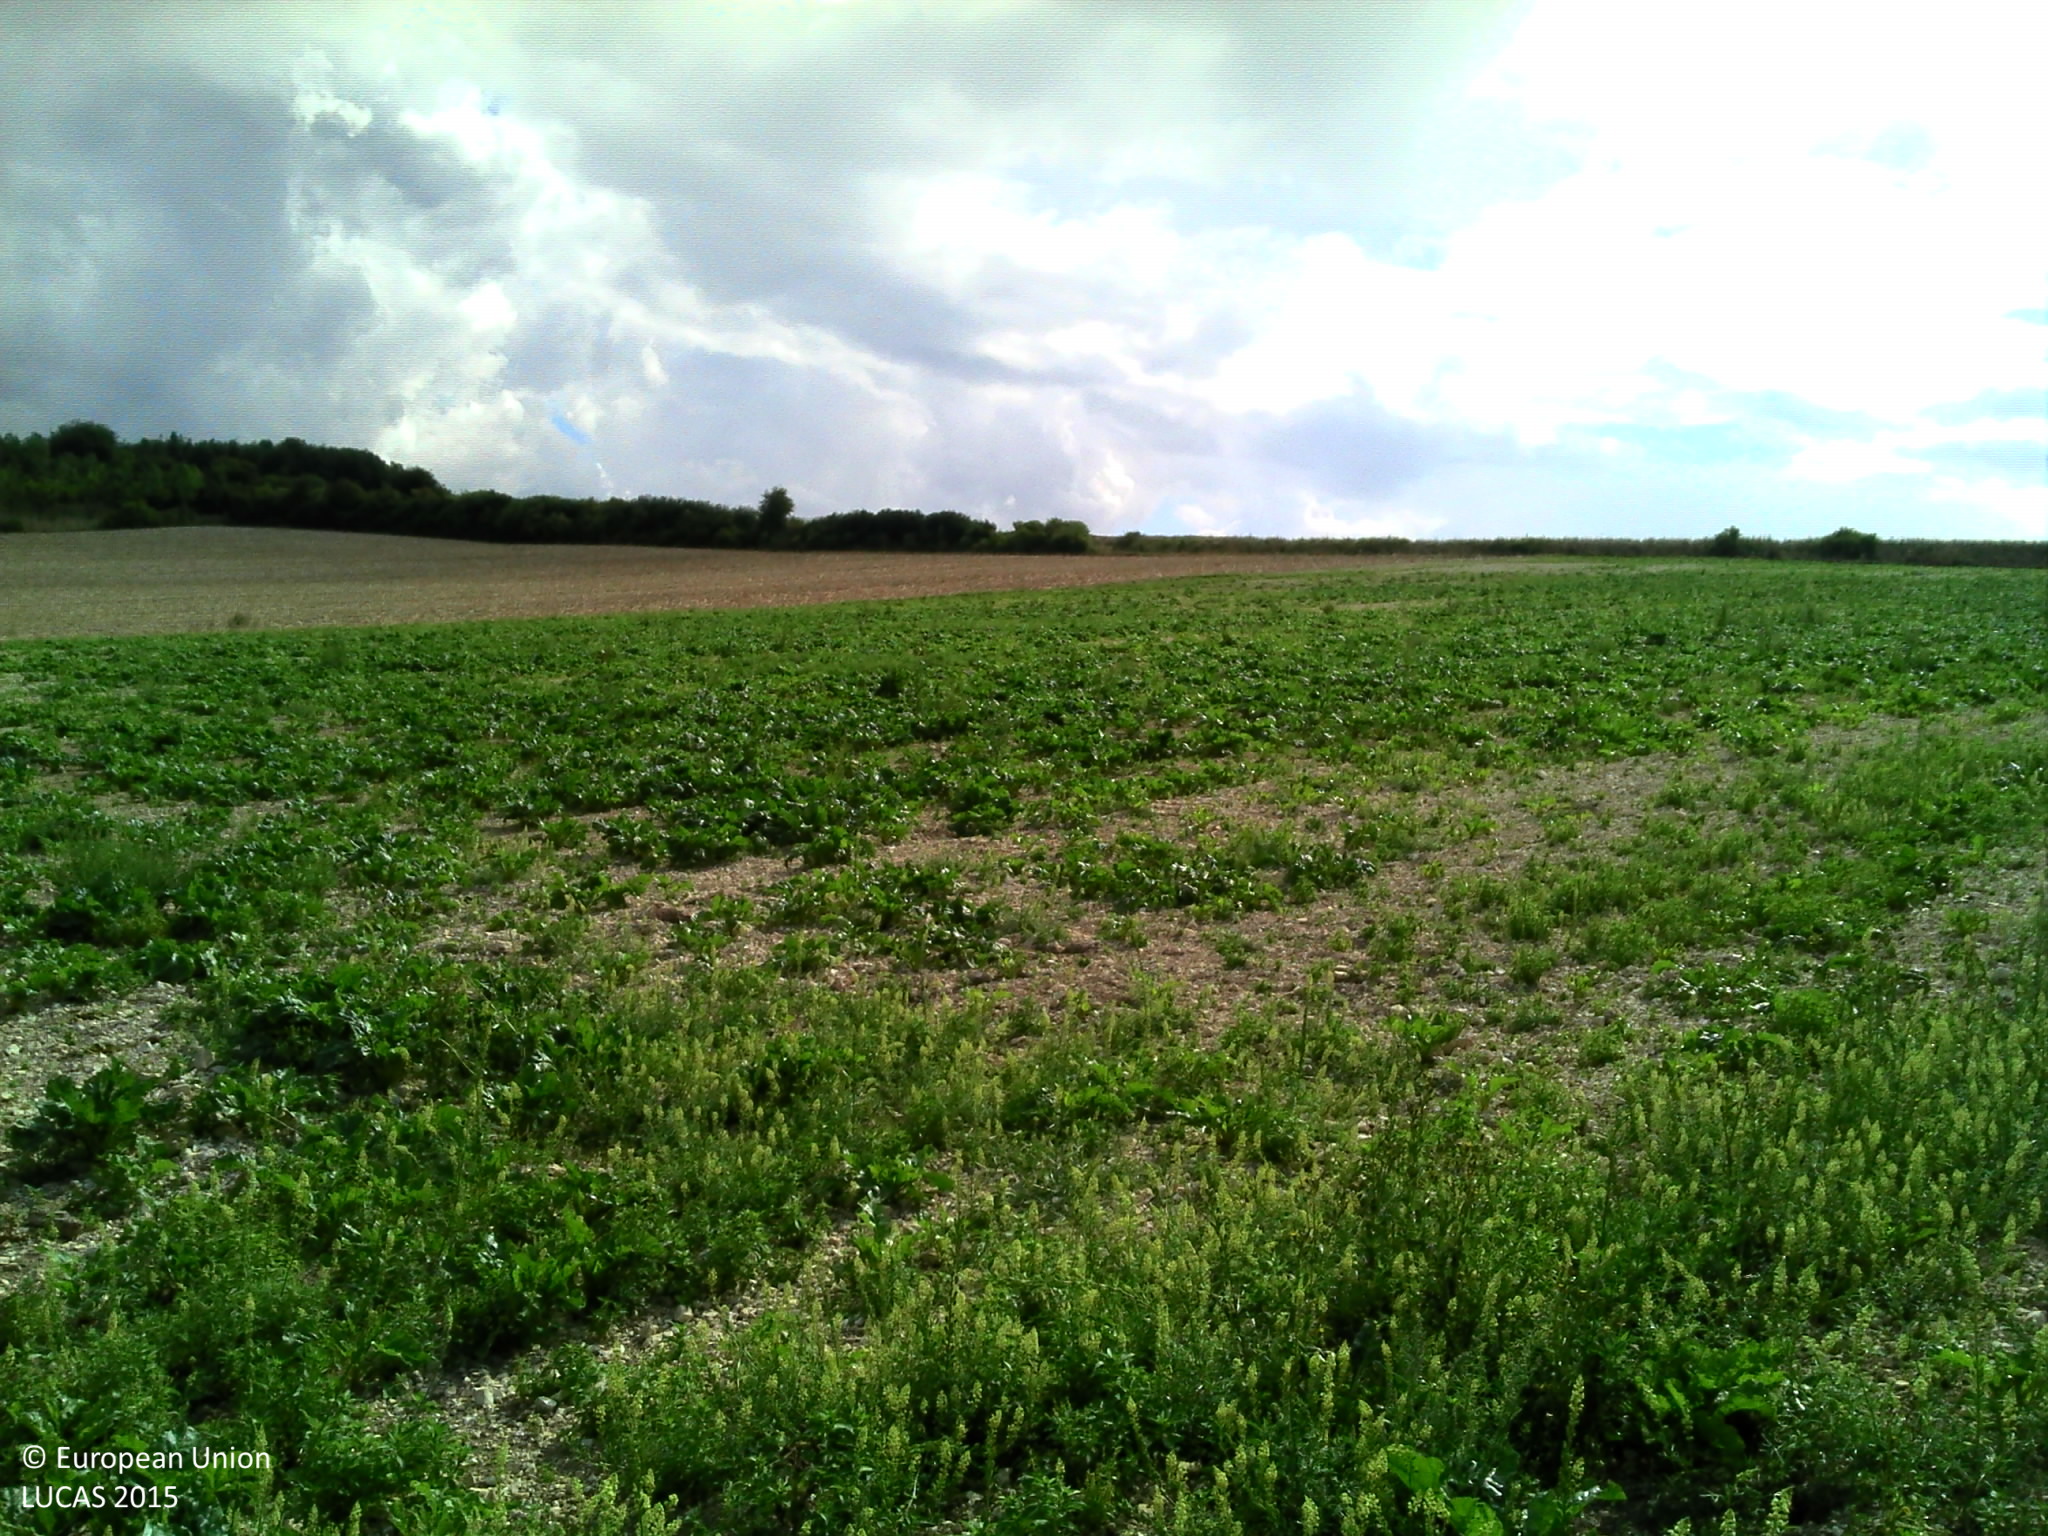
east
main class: Cropland
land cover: Rape and turnip rape
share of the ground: > 75 %
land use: Agriculture (excluding fallow land and kitchen gardens)
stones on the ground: 25 - 50 %
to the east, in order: Rape and turnip rape; Grass margins; Fences; Grassland without tree/shrub cover; Fences; Grass margins; Tracks; Grass margins; Other bare soil
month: July
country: FR
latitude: 50.0286
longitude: 2.5194
